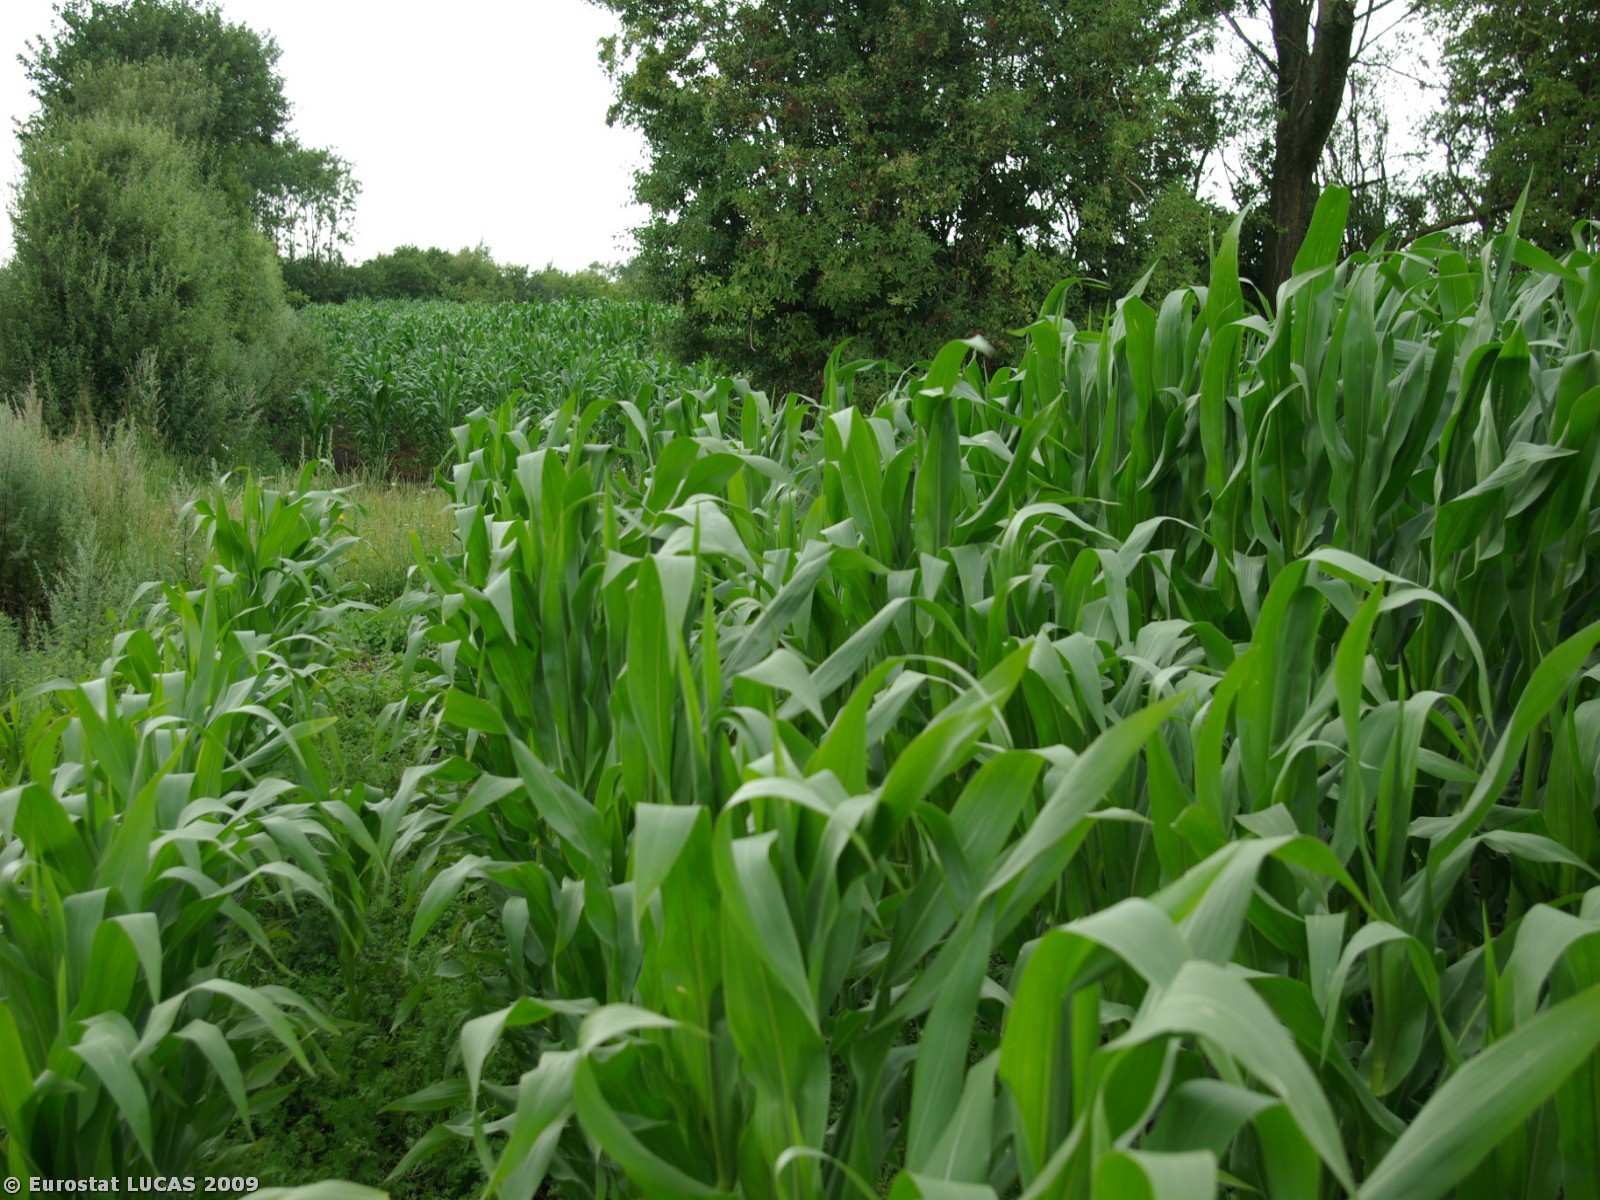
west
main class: Cropland
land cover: Maize
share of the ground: > 75 %
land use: Agriculture (excluding fallow land and kitchen gardens)
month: July
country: DK
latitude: 55.2125
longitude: 8.9165
